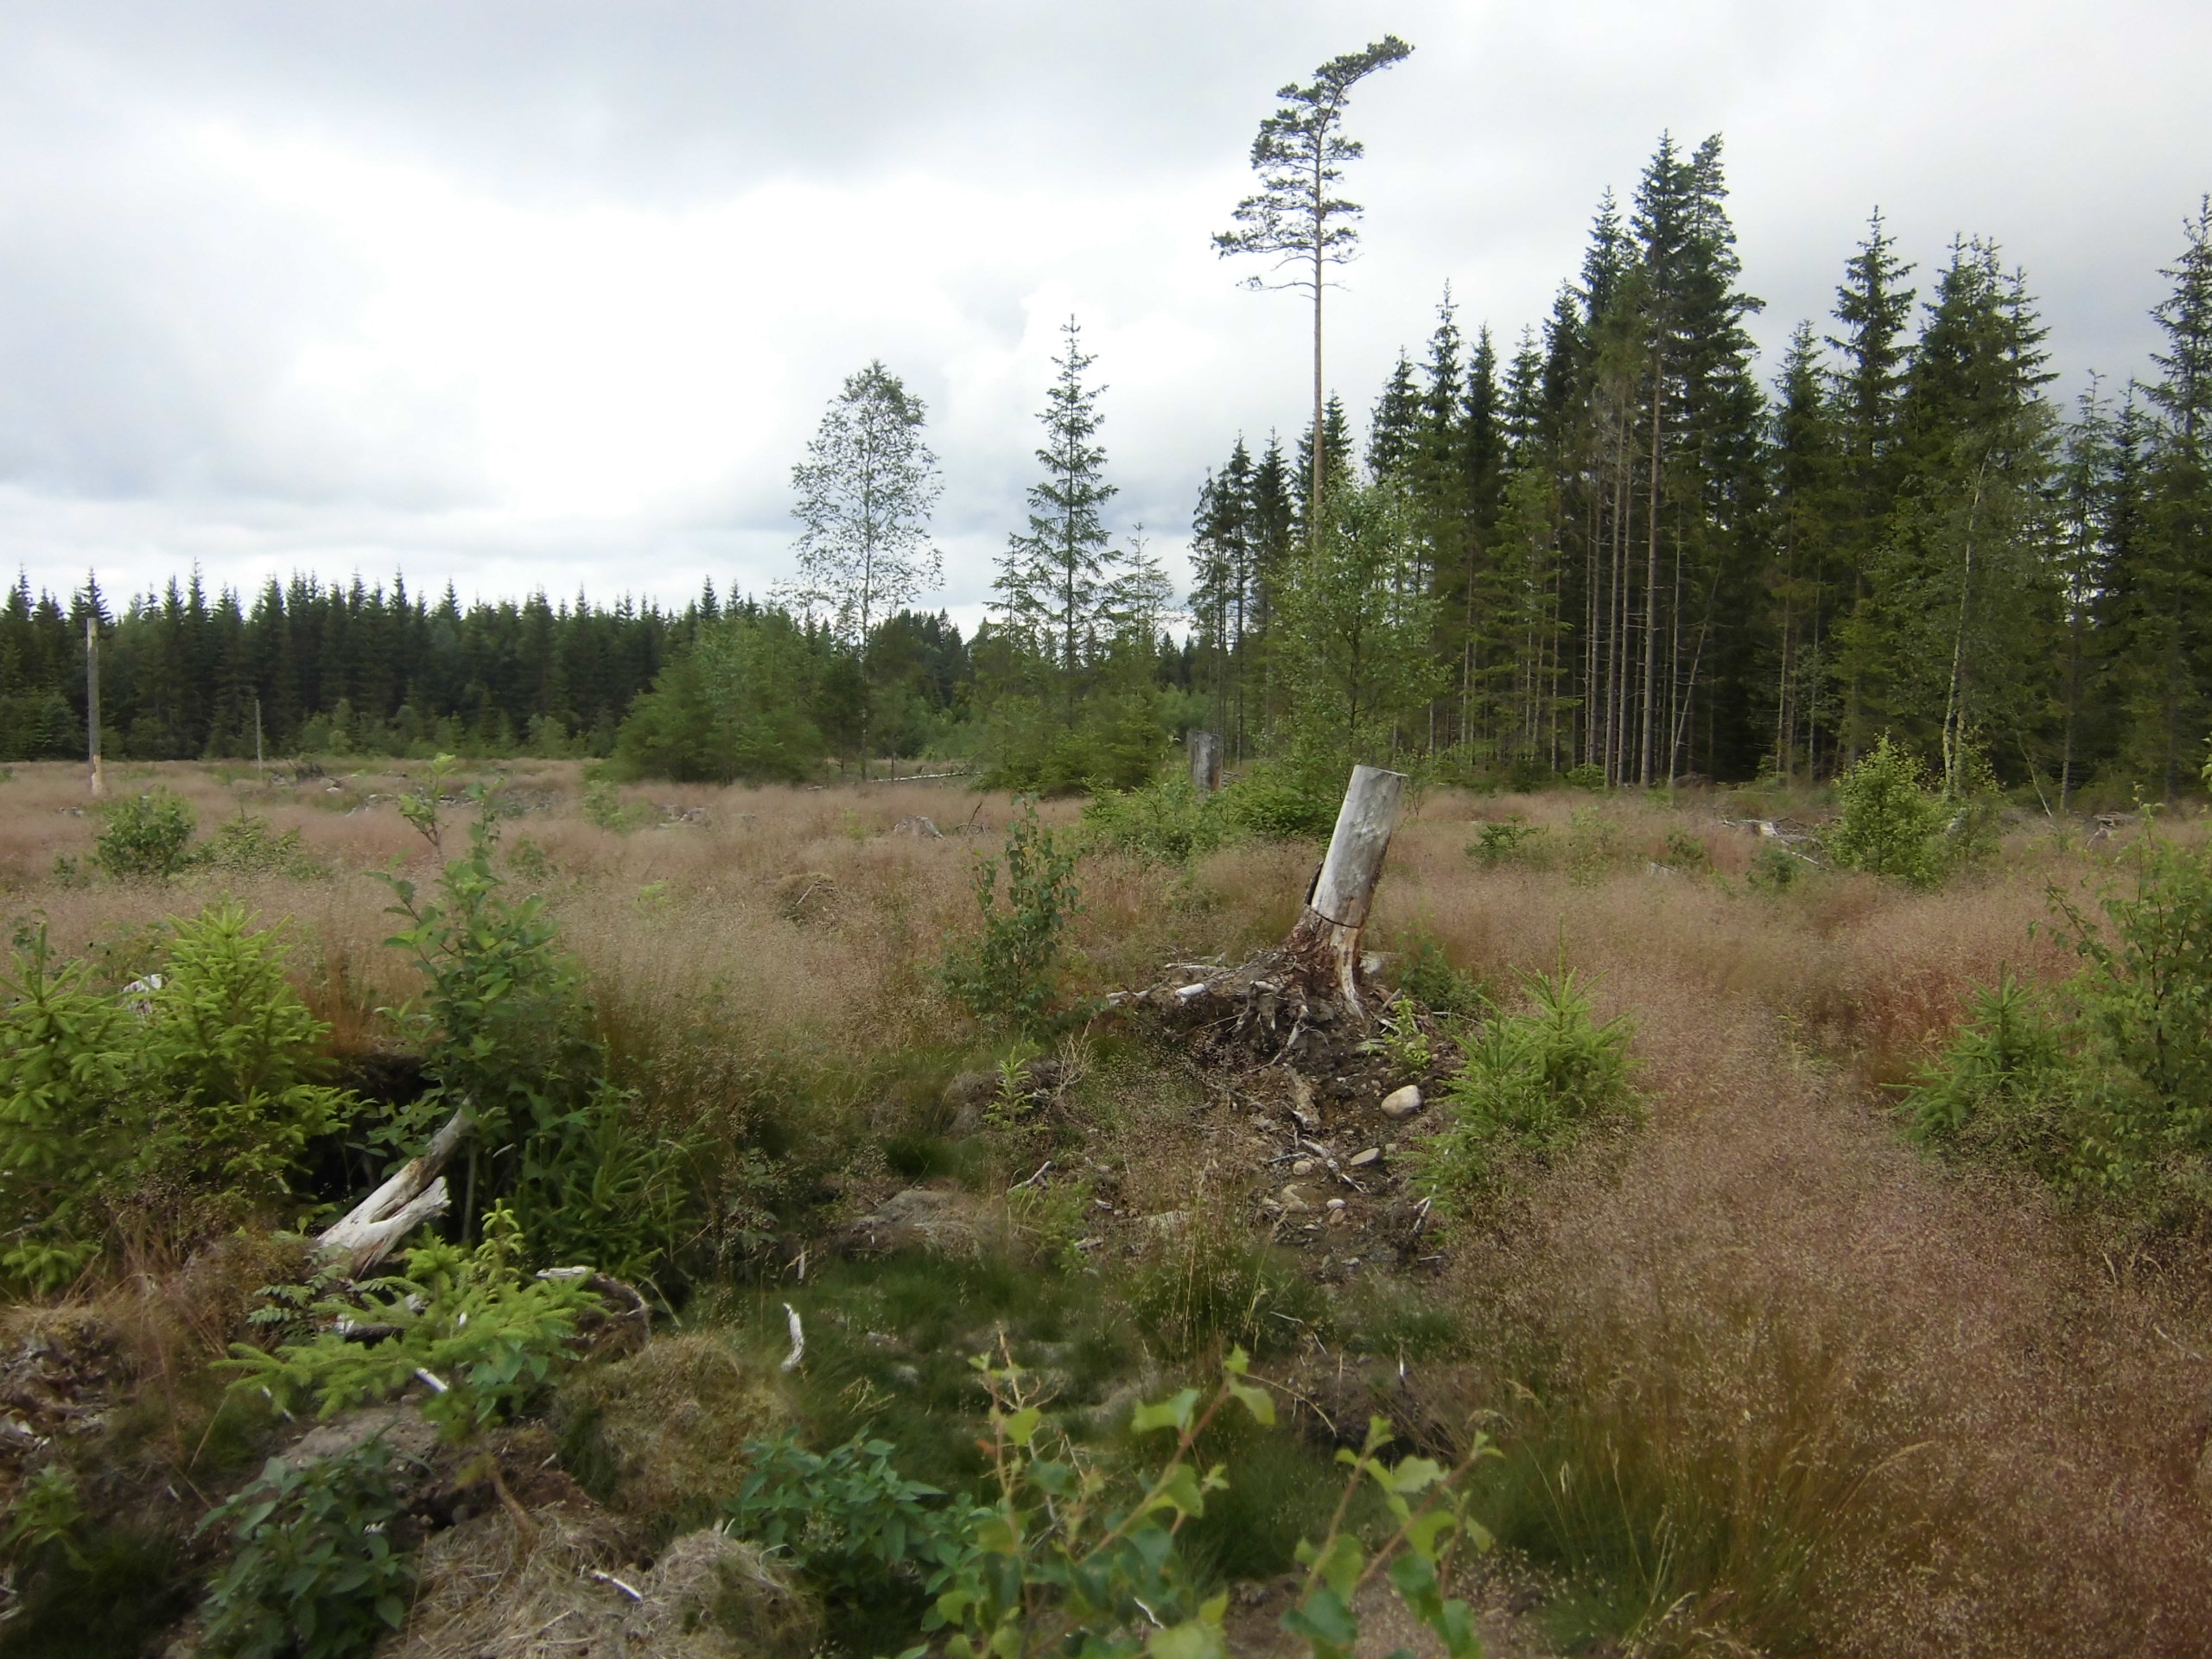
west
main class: Woodland
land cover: Spruce dominated mixed woodland
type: boreal forest
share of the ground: 25 - 50 %
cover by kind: herbaceous plants 45 %, broadleaved forest trees 15 %, coniferous forest trees 10 %, shrubs 10 %, lichens and mosses 10 %, unconsolidated bare surface 10 %
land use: Forestry
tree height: < 5 m
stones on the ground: 10 - 25 %
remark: Clear cut
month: July
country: SE
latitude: 57.4666
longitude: 14.8142
